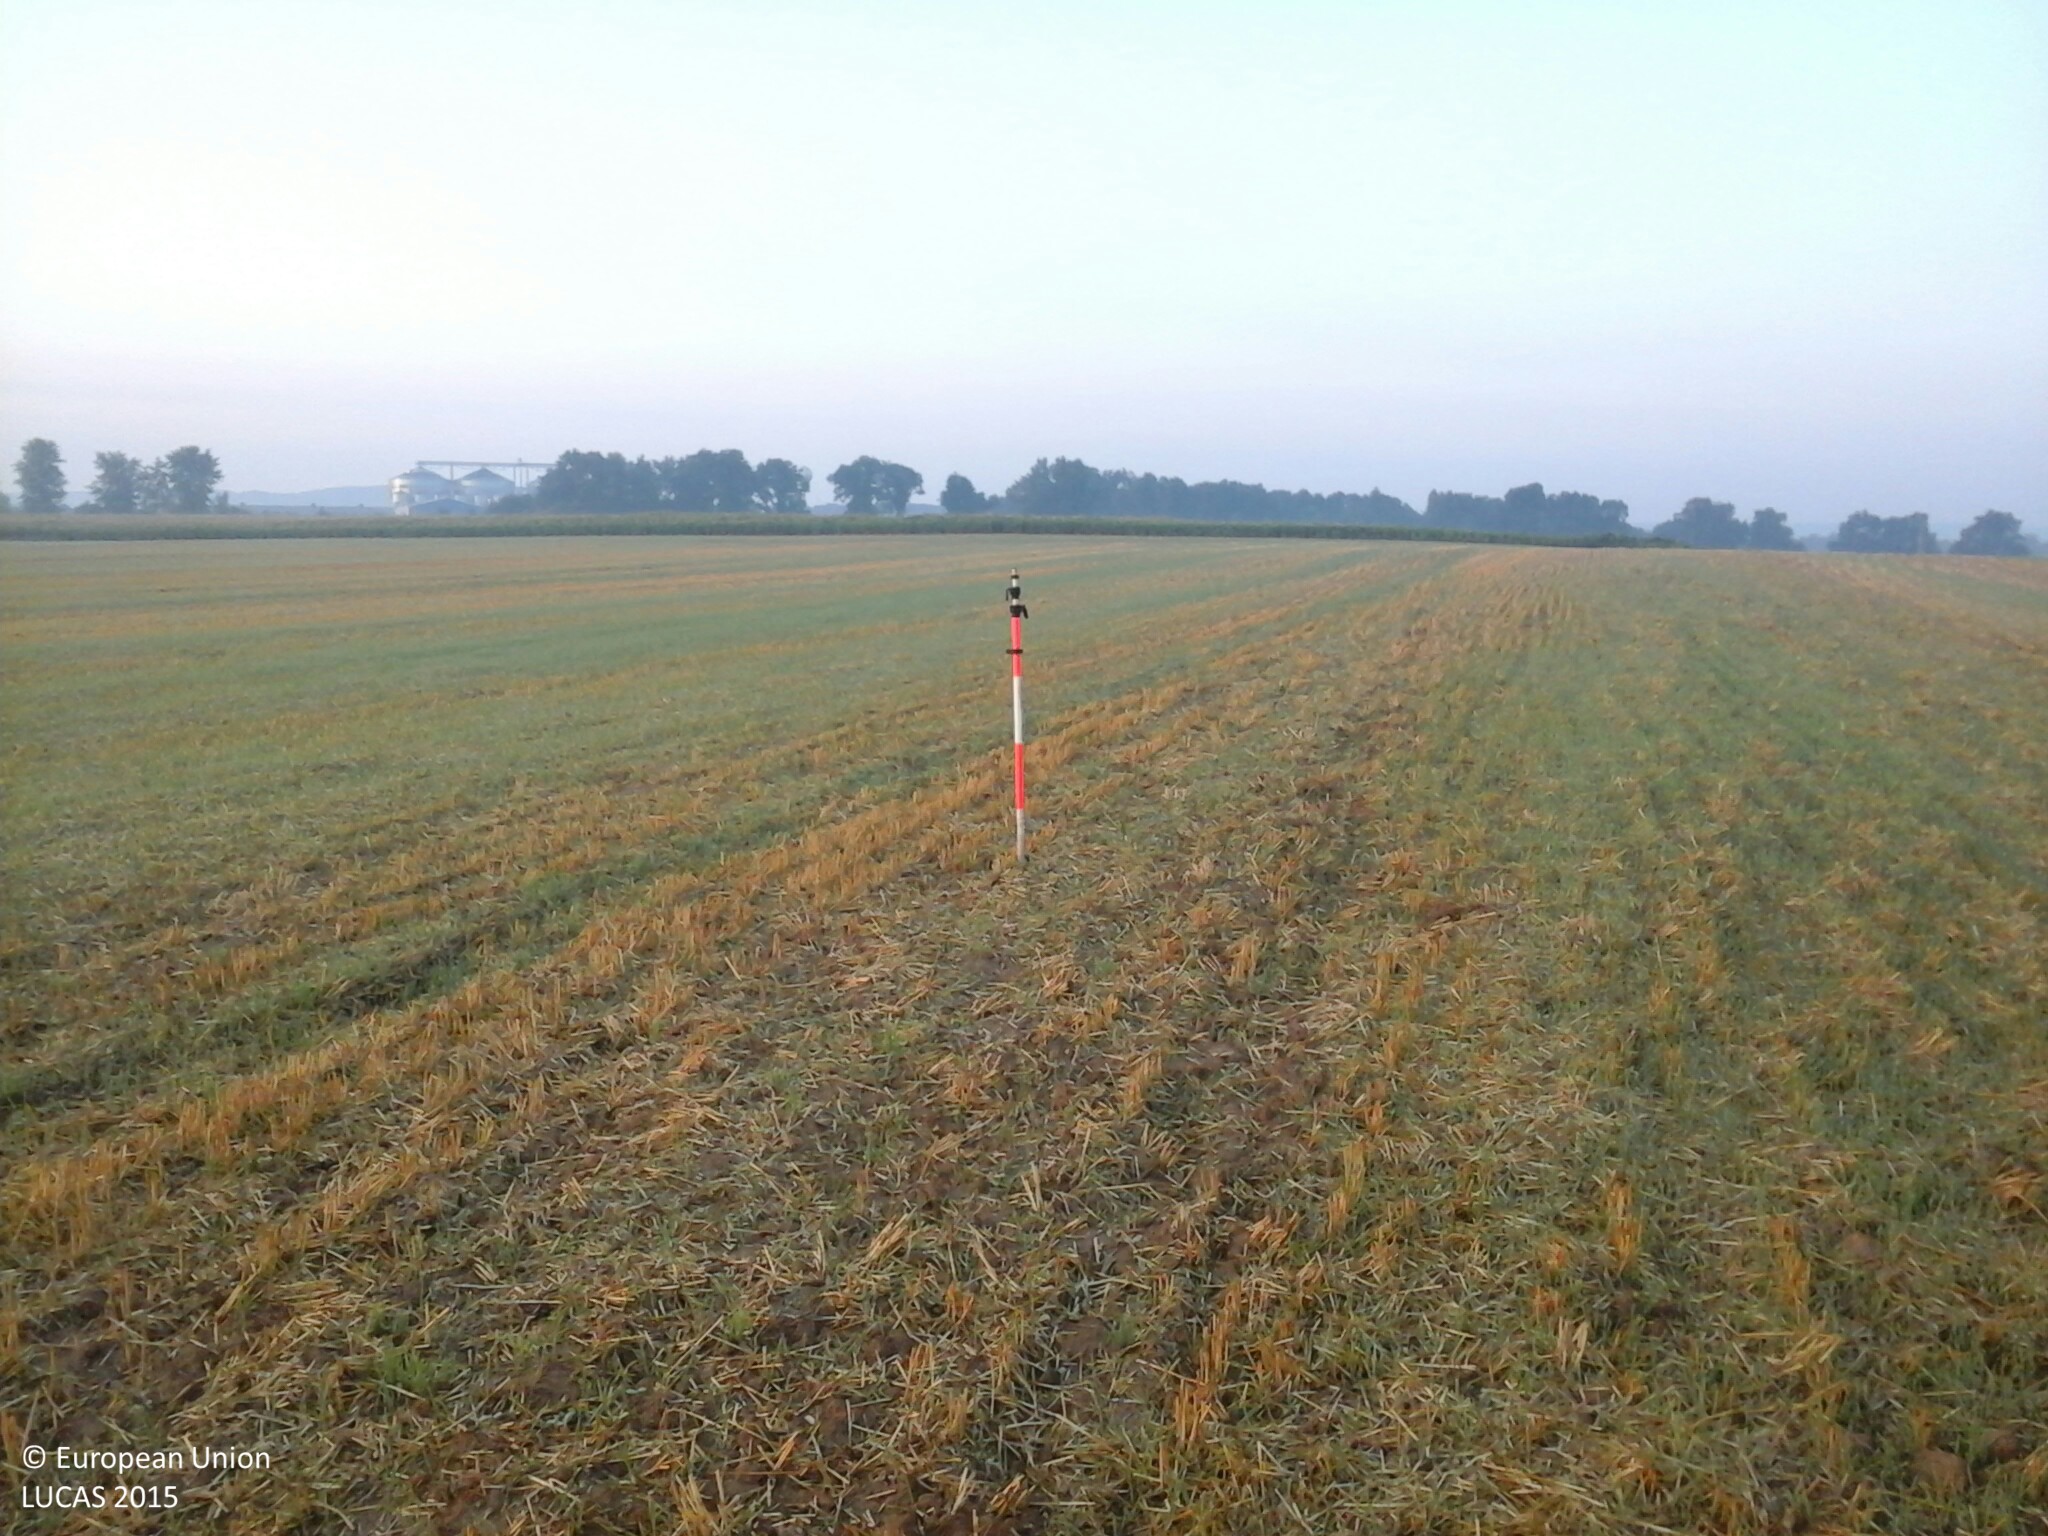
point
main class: Cropland
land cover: Common wheat
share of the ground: 50 - 75 %
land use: Agriculture (excluding fallow land and kitchen gardens)
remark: Harvested field
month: August
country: HU
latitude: 47.5272
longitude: 18.3407
